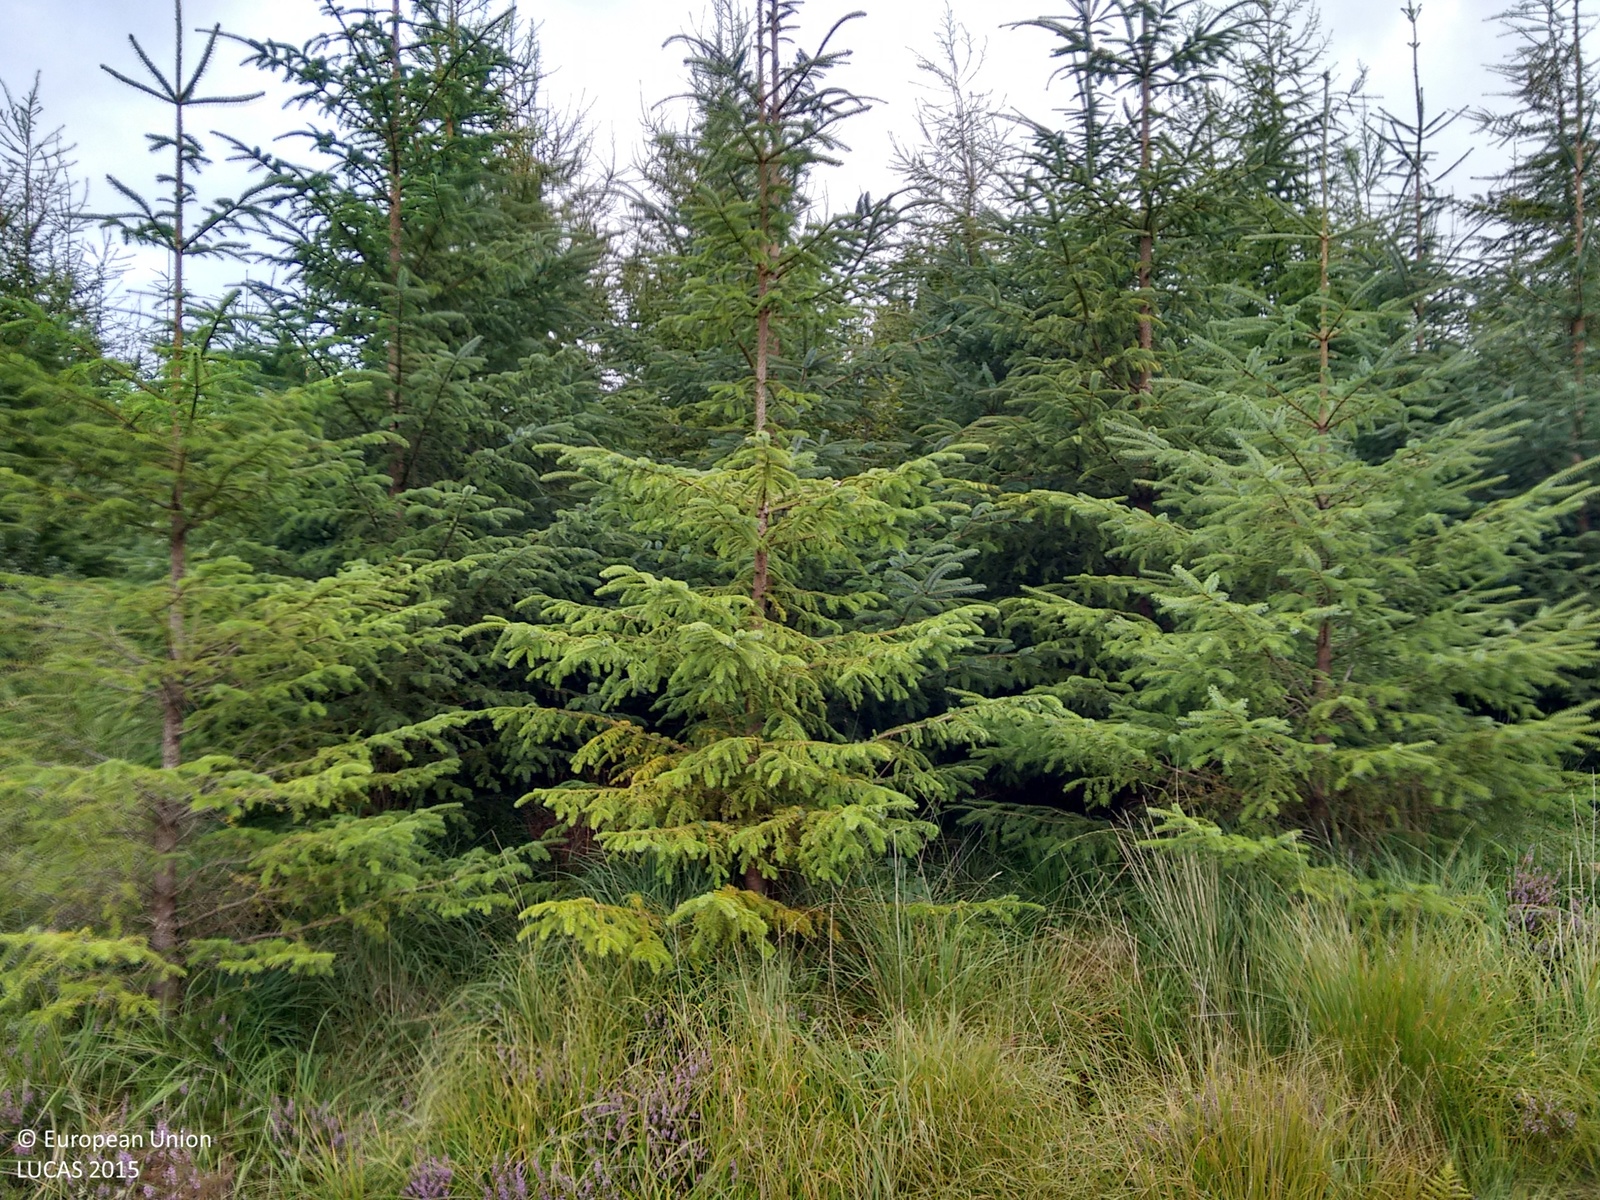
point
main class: Woodland
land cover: Spruce dominated coniferous woodland
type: exotic forest
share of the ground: > 75 %
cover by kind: coniferous forest trees 95 %, herbaceous plants 5 %
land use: Forestry
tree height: > 5 m
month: September
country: IE
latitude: 52.7993
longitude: -9.1286
